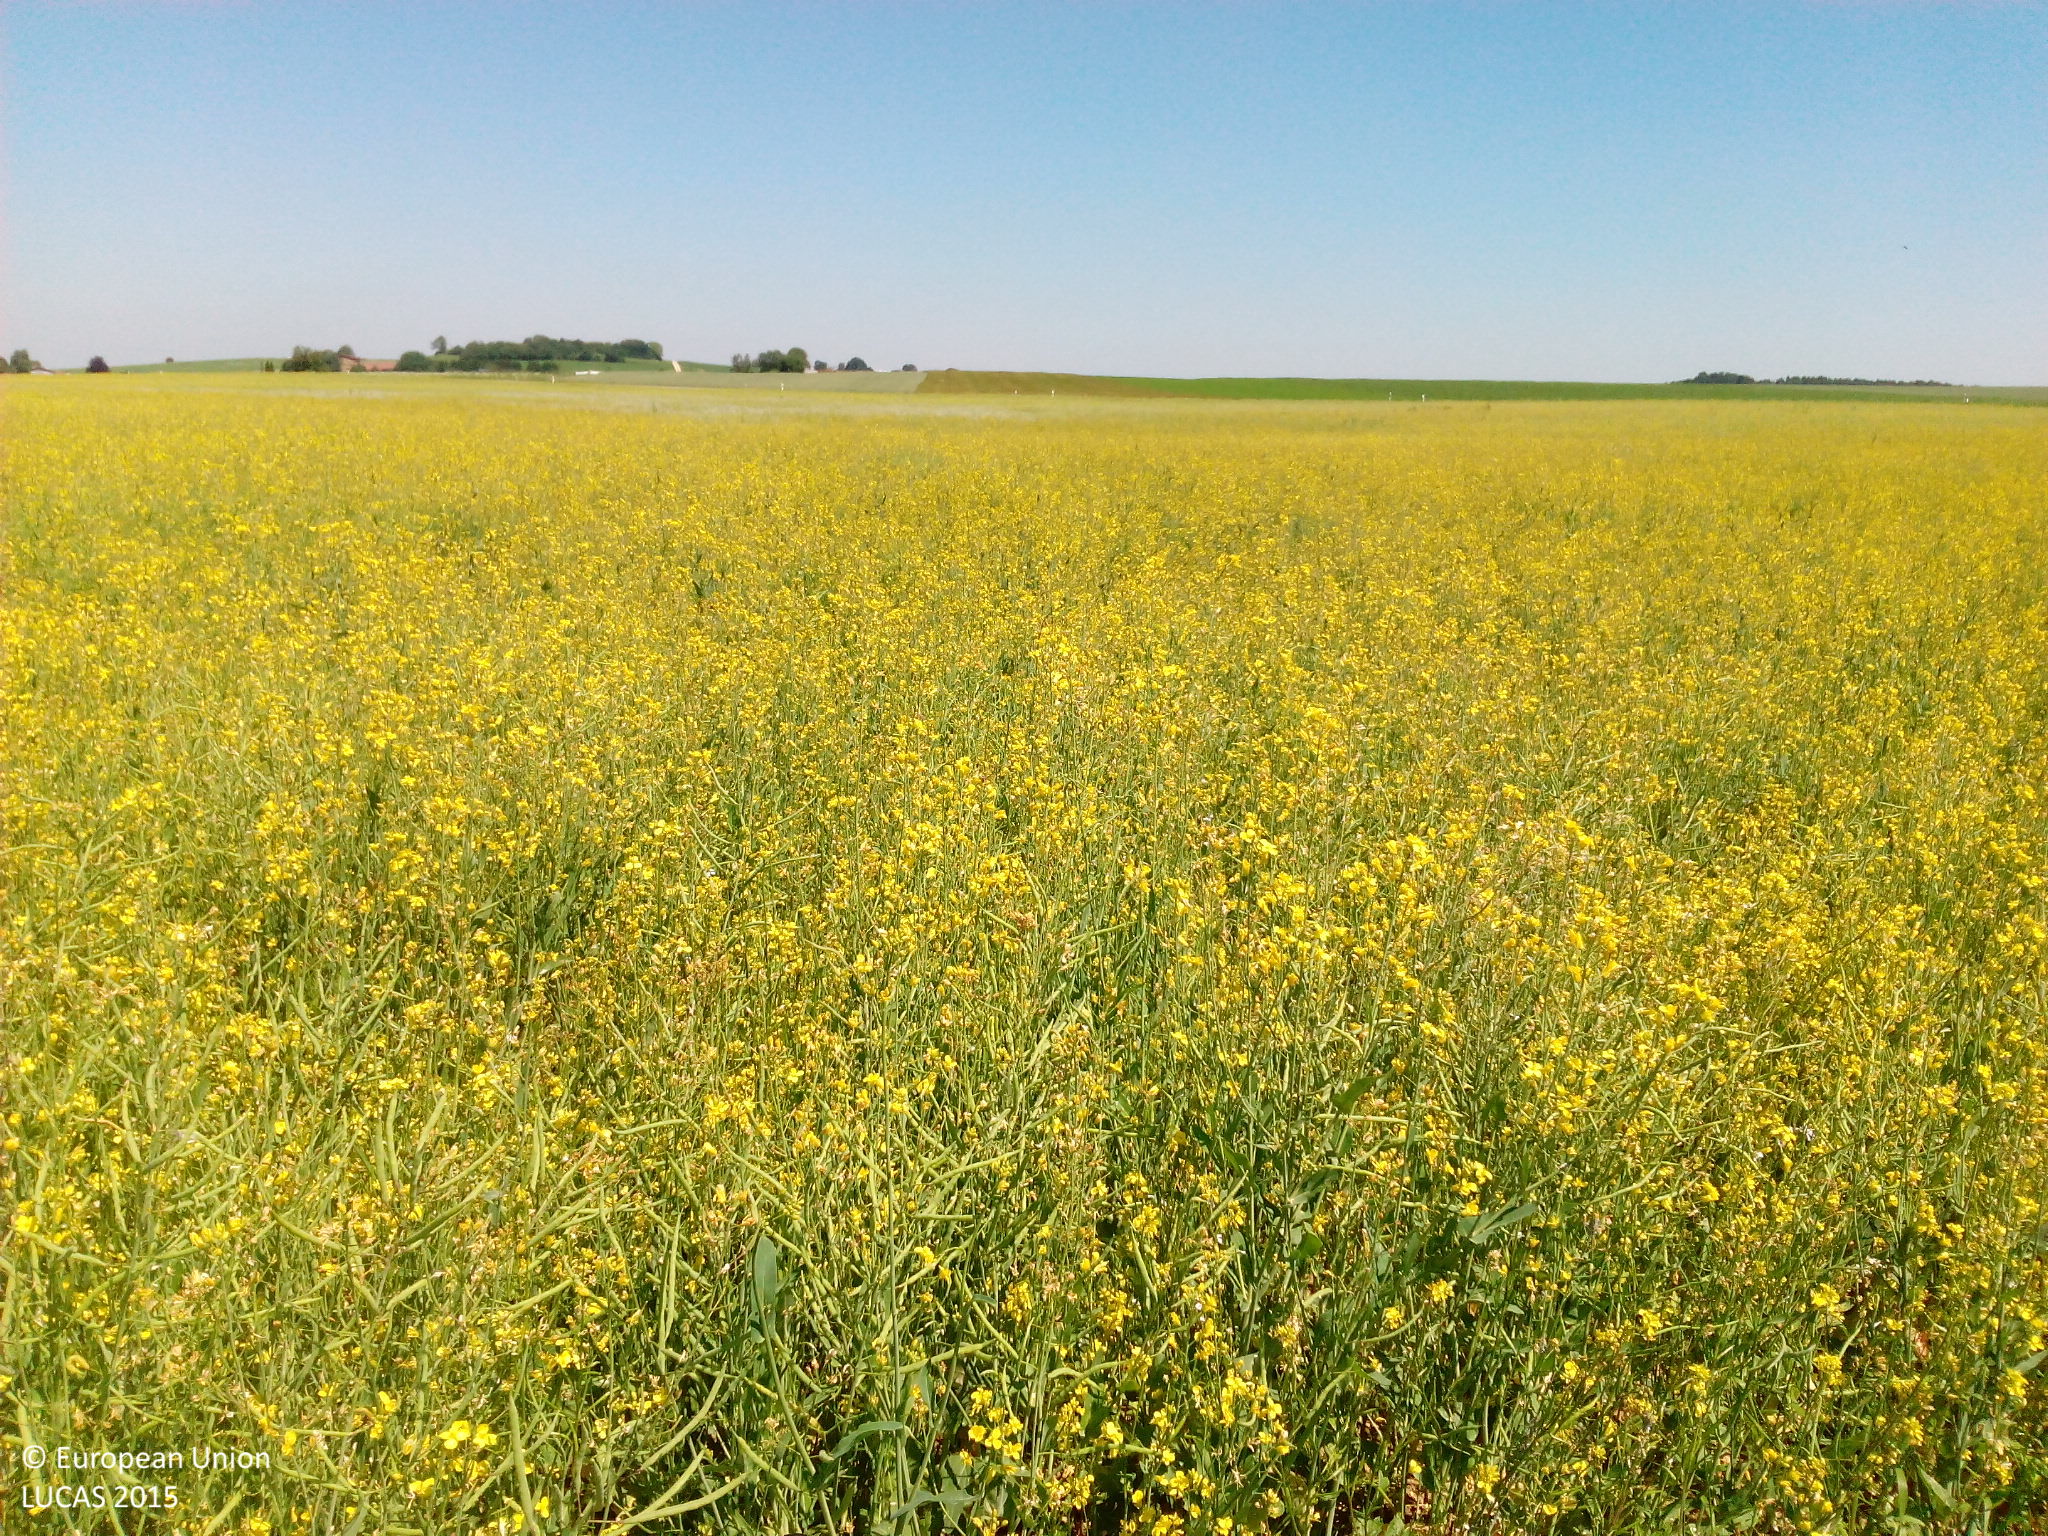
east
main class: Cropland
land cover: Rape and turnip rape
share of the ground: > 75 %
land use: Agriculture (excluding fallow land and kitchen gardens)
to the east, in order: Rape and turnip rape; Grass margins; Paved roads, cycling and walking lanes; Grassland without tree/shrub cover; Common wheat
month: July
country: DE
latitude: 48.3120
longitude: 9.4205
